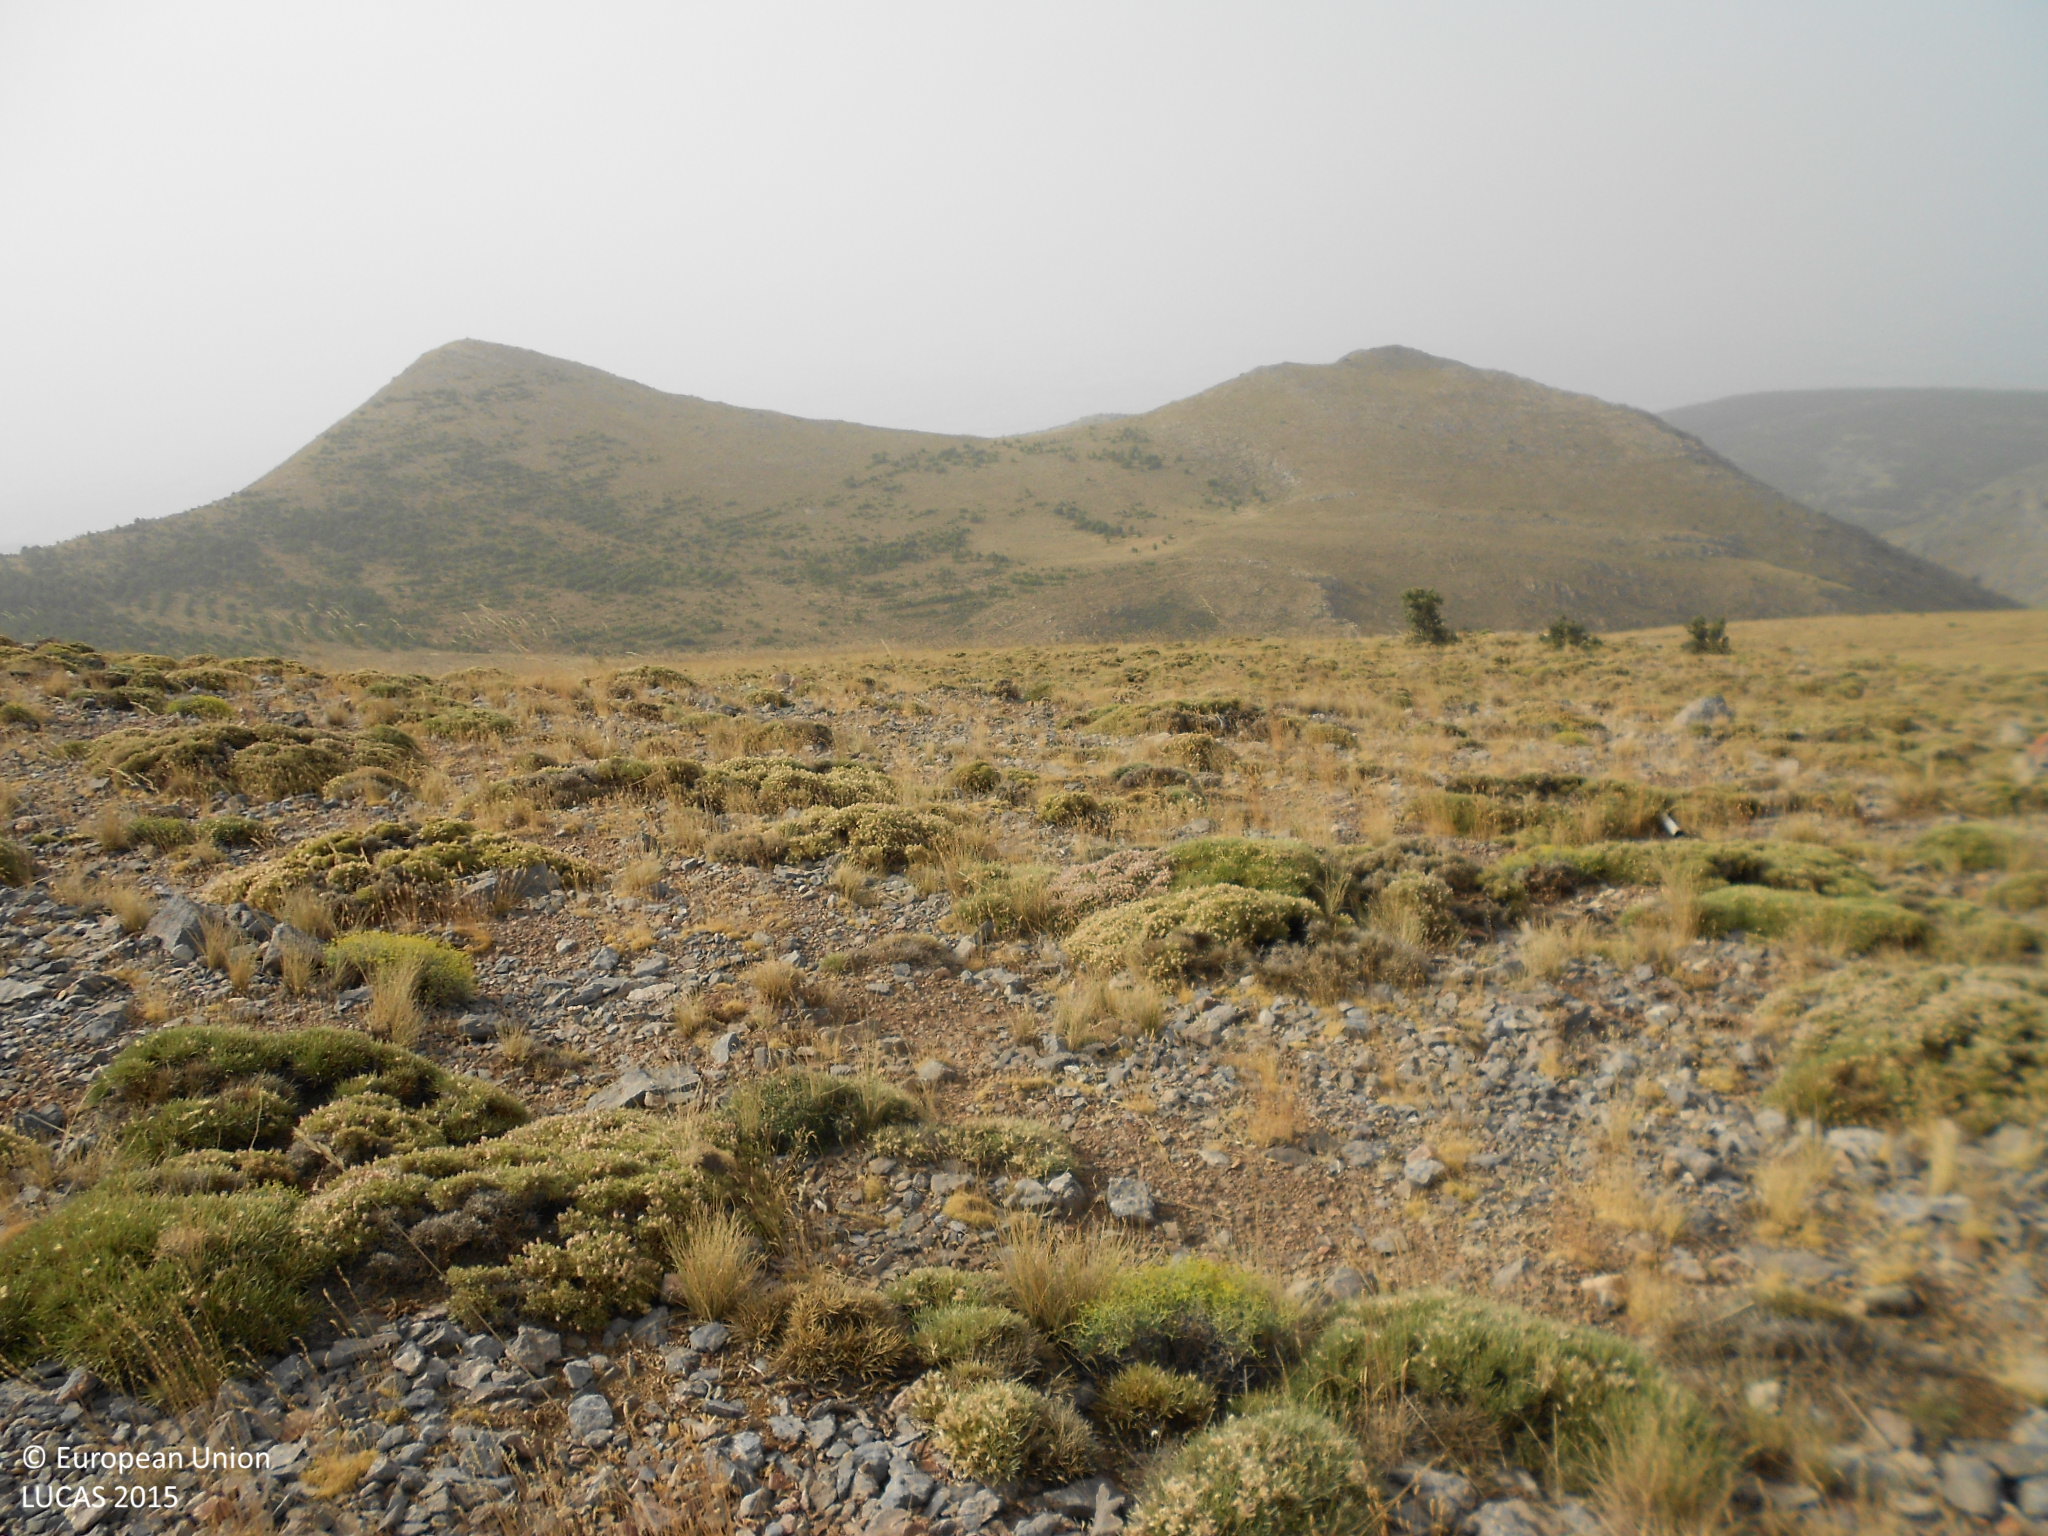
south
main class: Shrubland
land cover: Shrubland without tree cover
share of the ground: > 75 %
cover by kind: herbaceous plants 55 %, shrubs 25 %, consolidated bare surface 10 %, unconsolidated bare surface 10 %
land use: Semi-natural and natural areas not in use
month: August
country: ES
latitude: 36.8785
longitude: -2.8015
